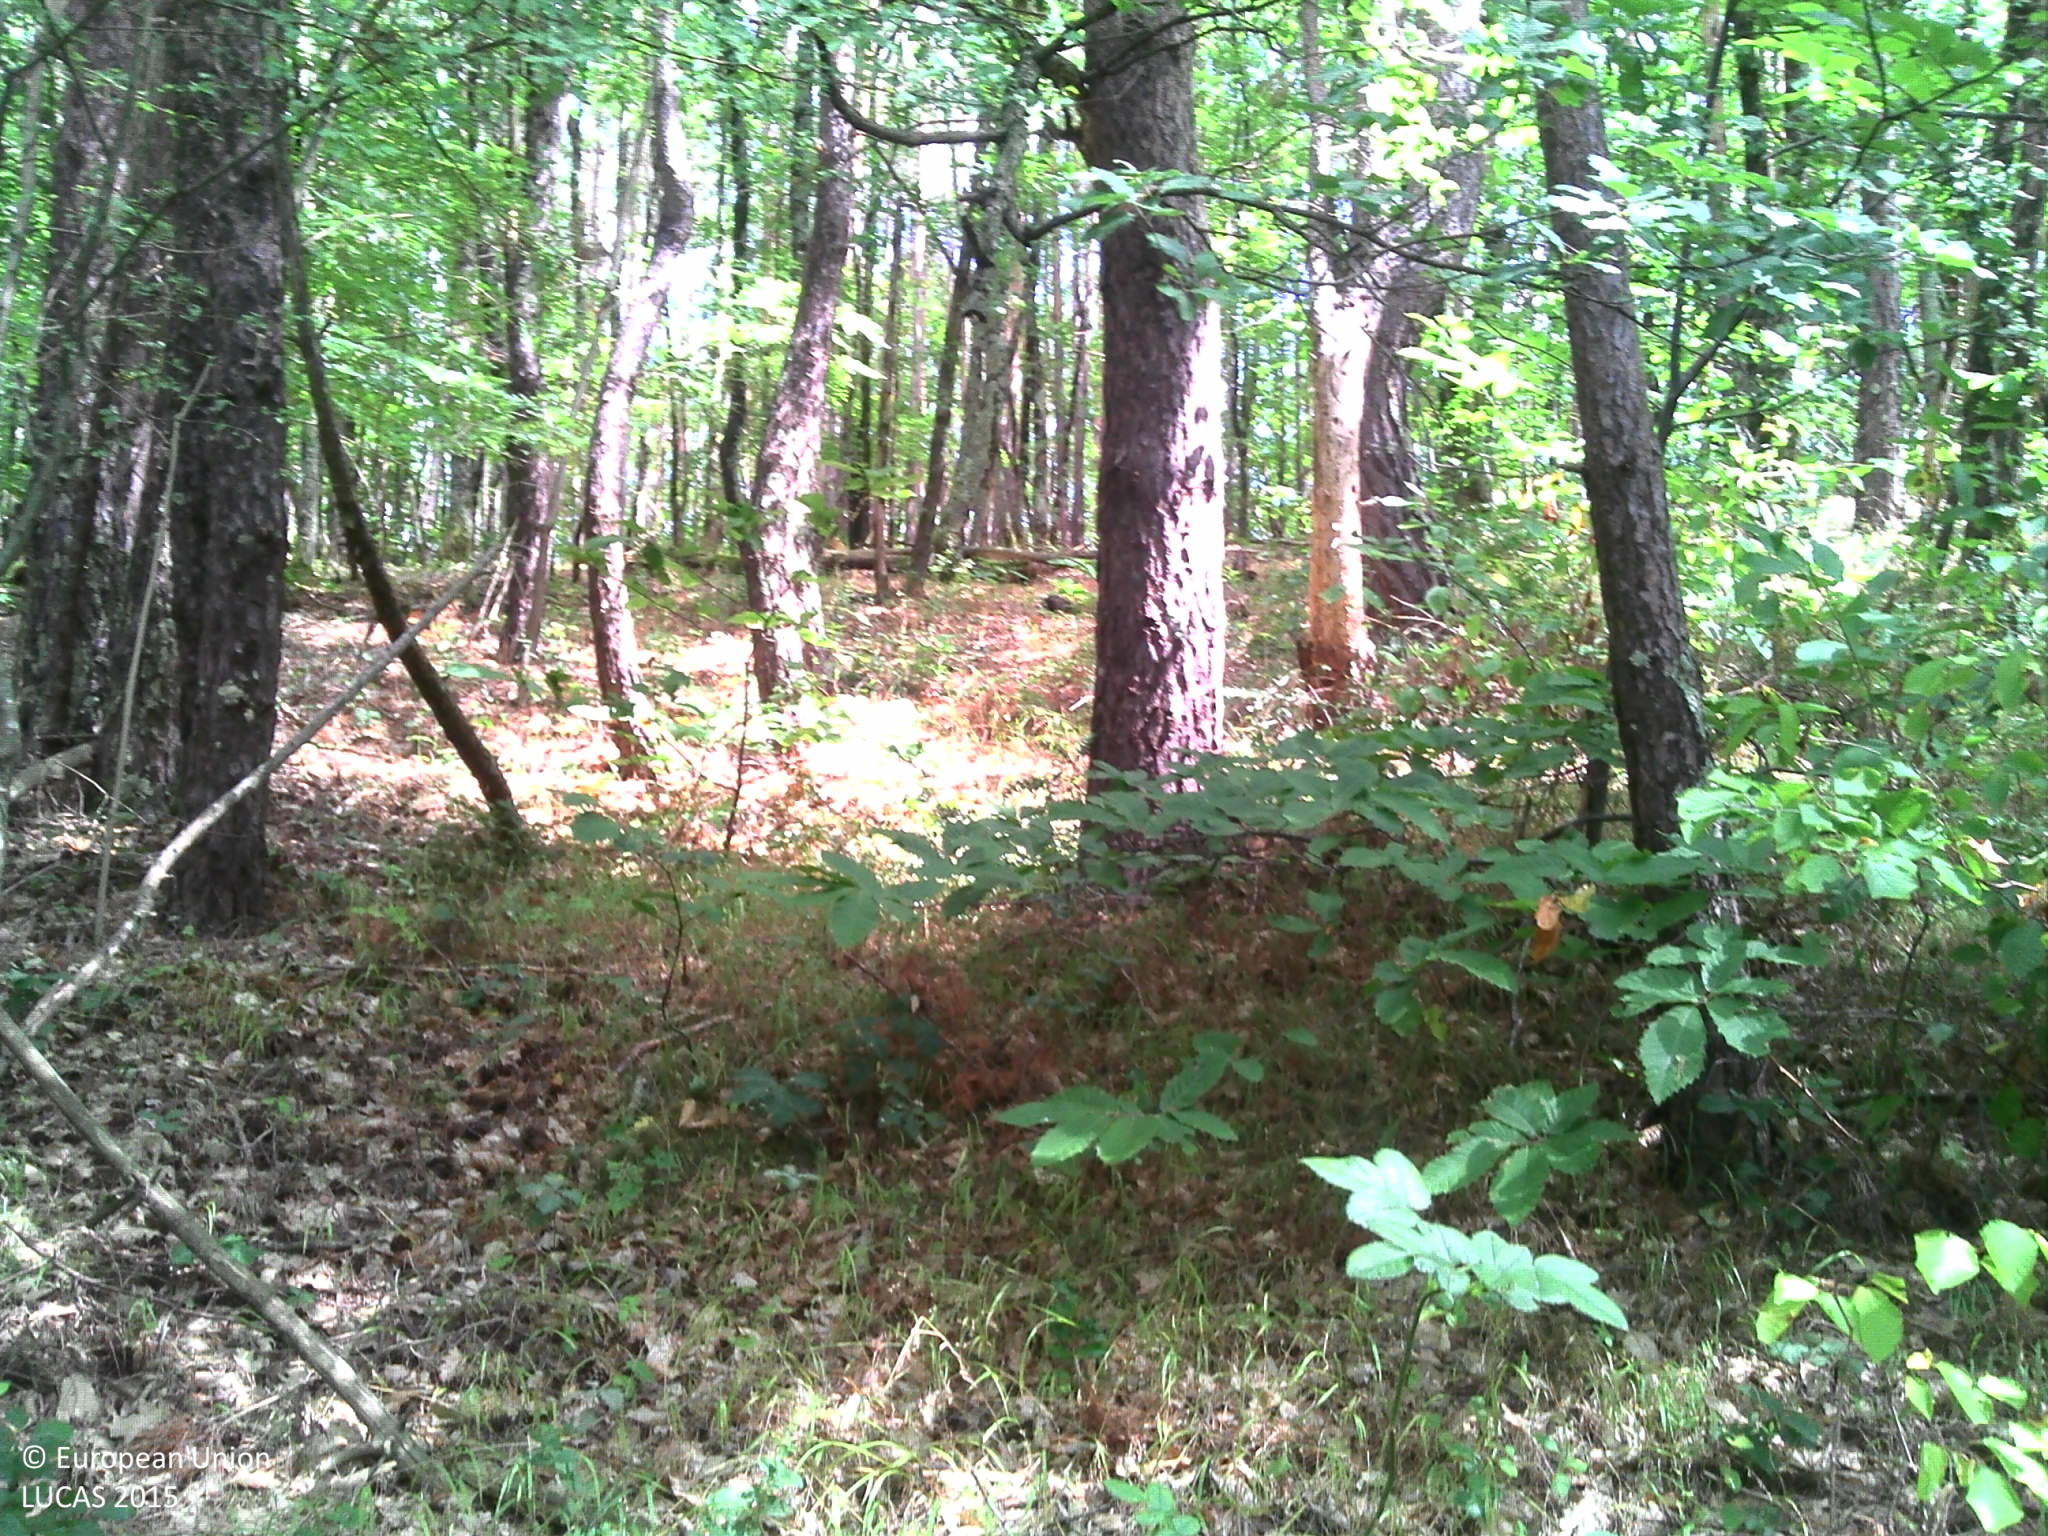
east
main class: Woodland
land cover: Pine dominated mixed woodland
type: hemiboreal forest and nemoral coniferous forest and mixed broadleaved-coniferous forest
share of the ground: > 75 %
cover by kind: broadleaved forest trees 40 %, coniferous forest trees 35 %, unconsolidated bare surface 15 %, herbaceous plants 10 %
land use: Semi-natural and natural areas not in use
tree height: > 5 m
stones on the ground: 10 - 25 %
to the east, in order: Pine dominated mixed woodland; Broadleaved woodland; Tracks; Broadleaved woodland; Pine dominated mixed woodland; Broadleaved woodland; Rivers and streams; Broadleaved woodland; Shrubland with sparse tree cover; Spruce dominated coniferous woodland; Broadleaved woodland
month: August
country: FR
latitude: 44.8798
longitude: 4.6254
